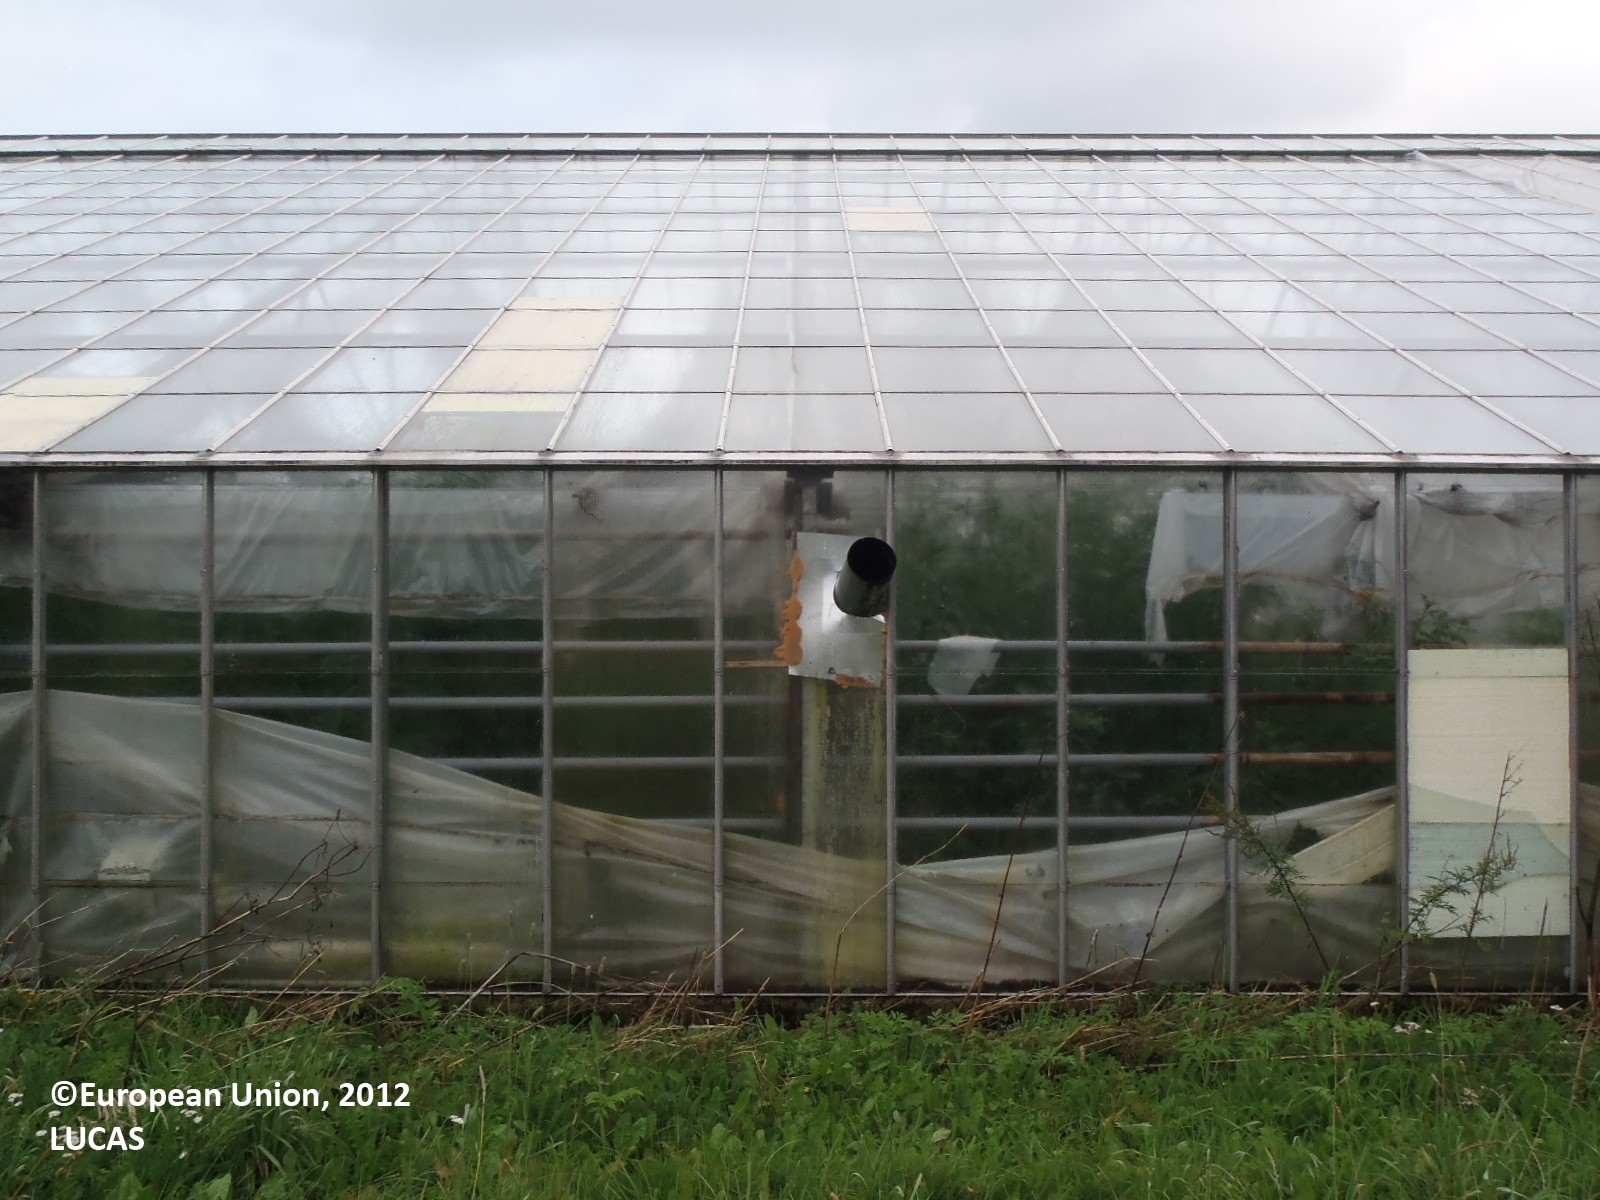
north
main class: Grassland
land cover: Grassland without tree/shrub cover
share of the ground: > 75 %
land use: Commerce, finance, business
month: August
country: FI
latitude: 60.8738
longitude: 22.3877
